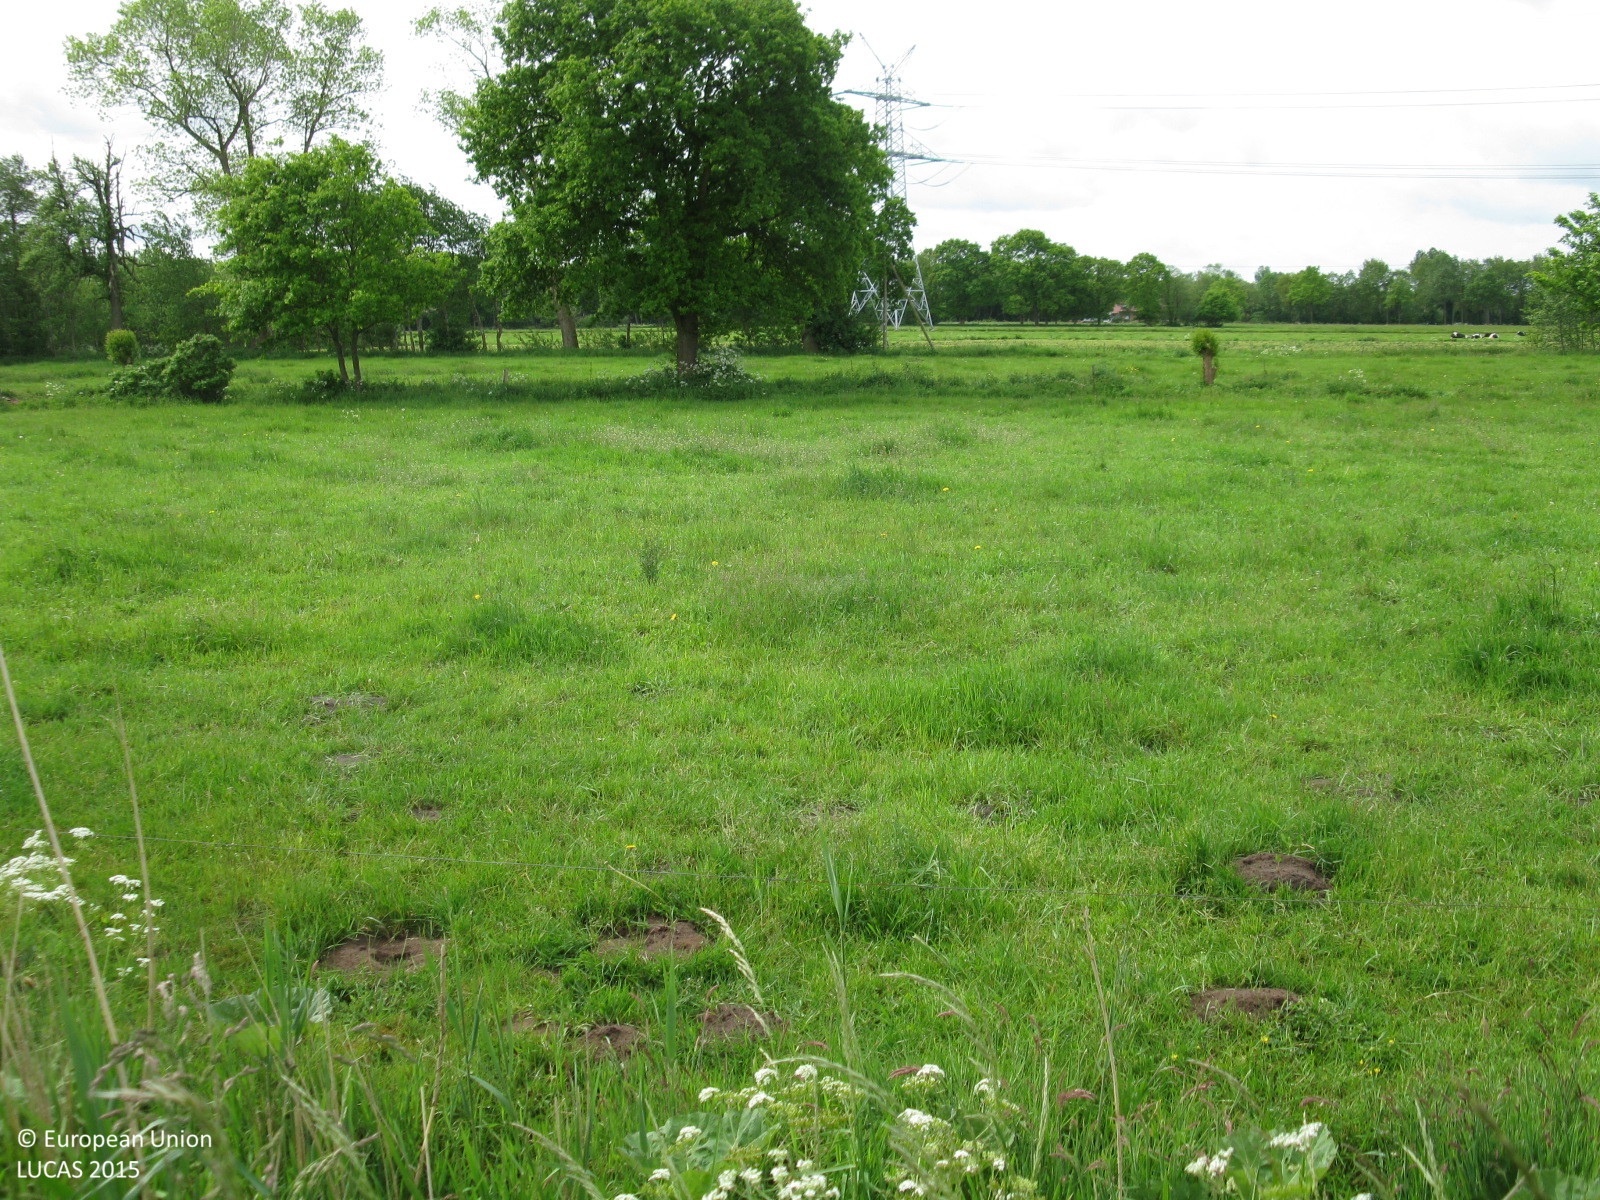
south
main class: Grassland
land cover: Grassland without tree/shrub cover
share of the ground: > 75 %
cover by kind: herbaceous plants 100 %
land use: Agriculture (excluding fallow land and kitchen gardens)
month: June
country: DE
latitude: 53.1380
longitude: 7.2949
